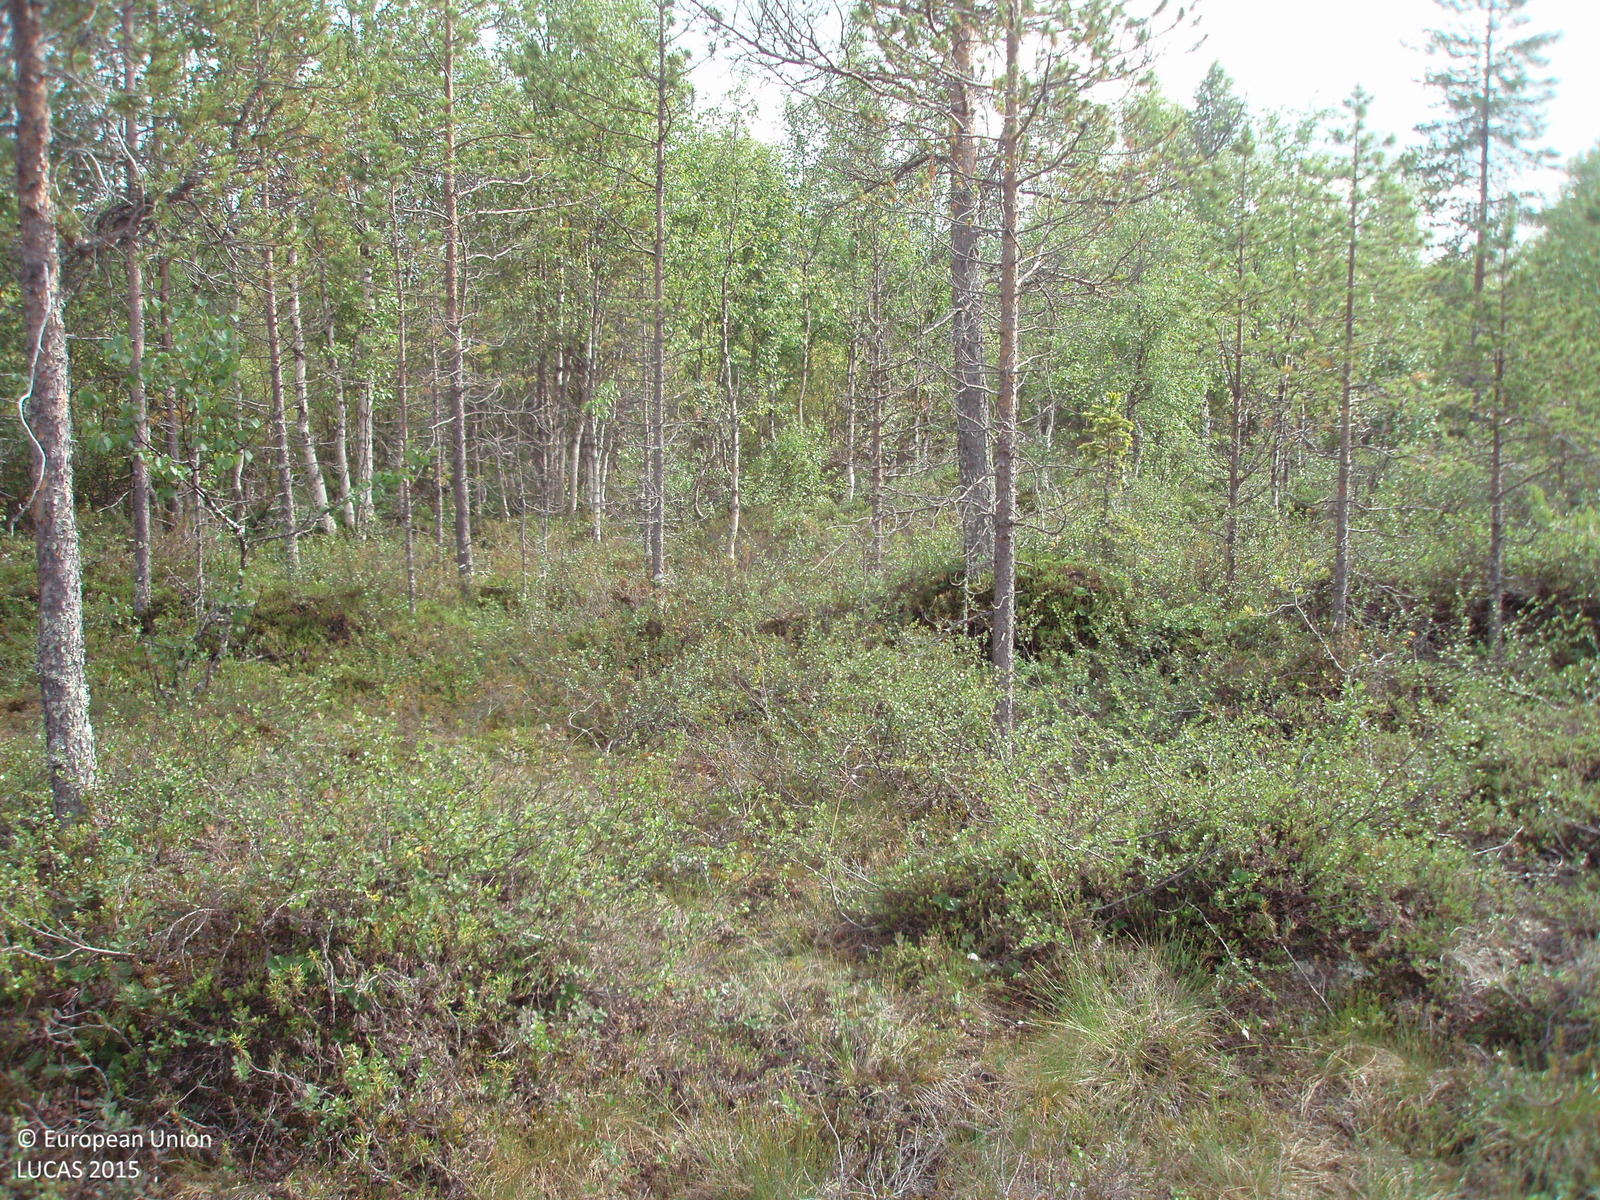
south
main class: Woodland
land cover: Pine dominated coniferous woodland
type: boreal forest
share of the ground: 10 - 25 %
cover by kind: shrubs 60 %, coniferous forest trees 20 %, lichens and mosses 15 %, herbaceous plants 5 %
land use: Semi-natural and natural areas not in use
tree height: > 5 m
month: July
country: FI
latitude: 66.8802
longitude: 28.5591
